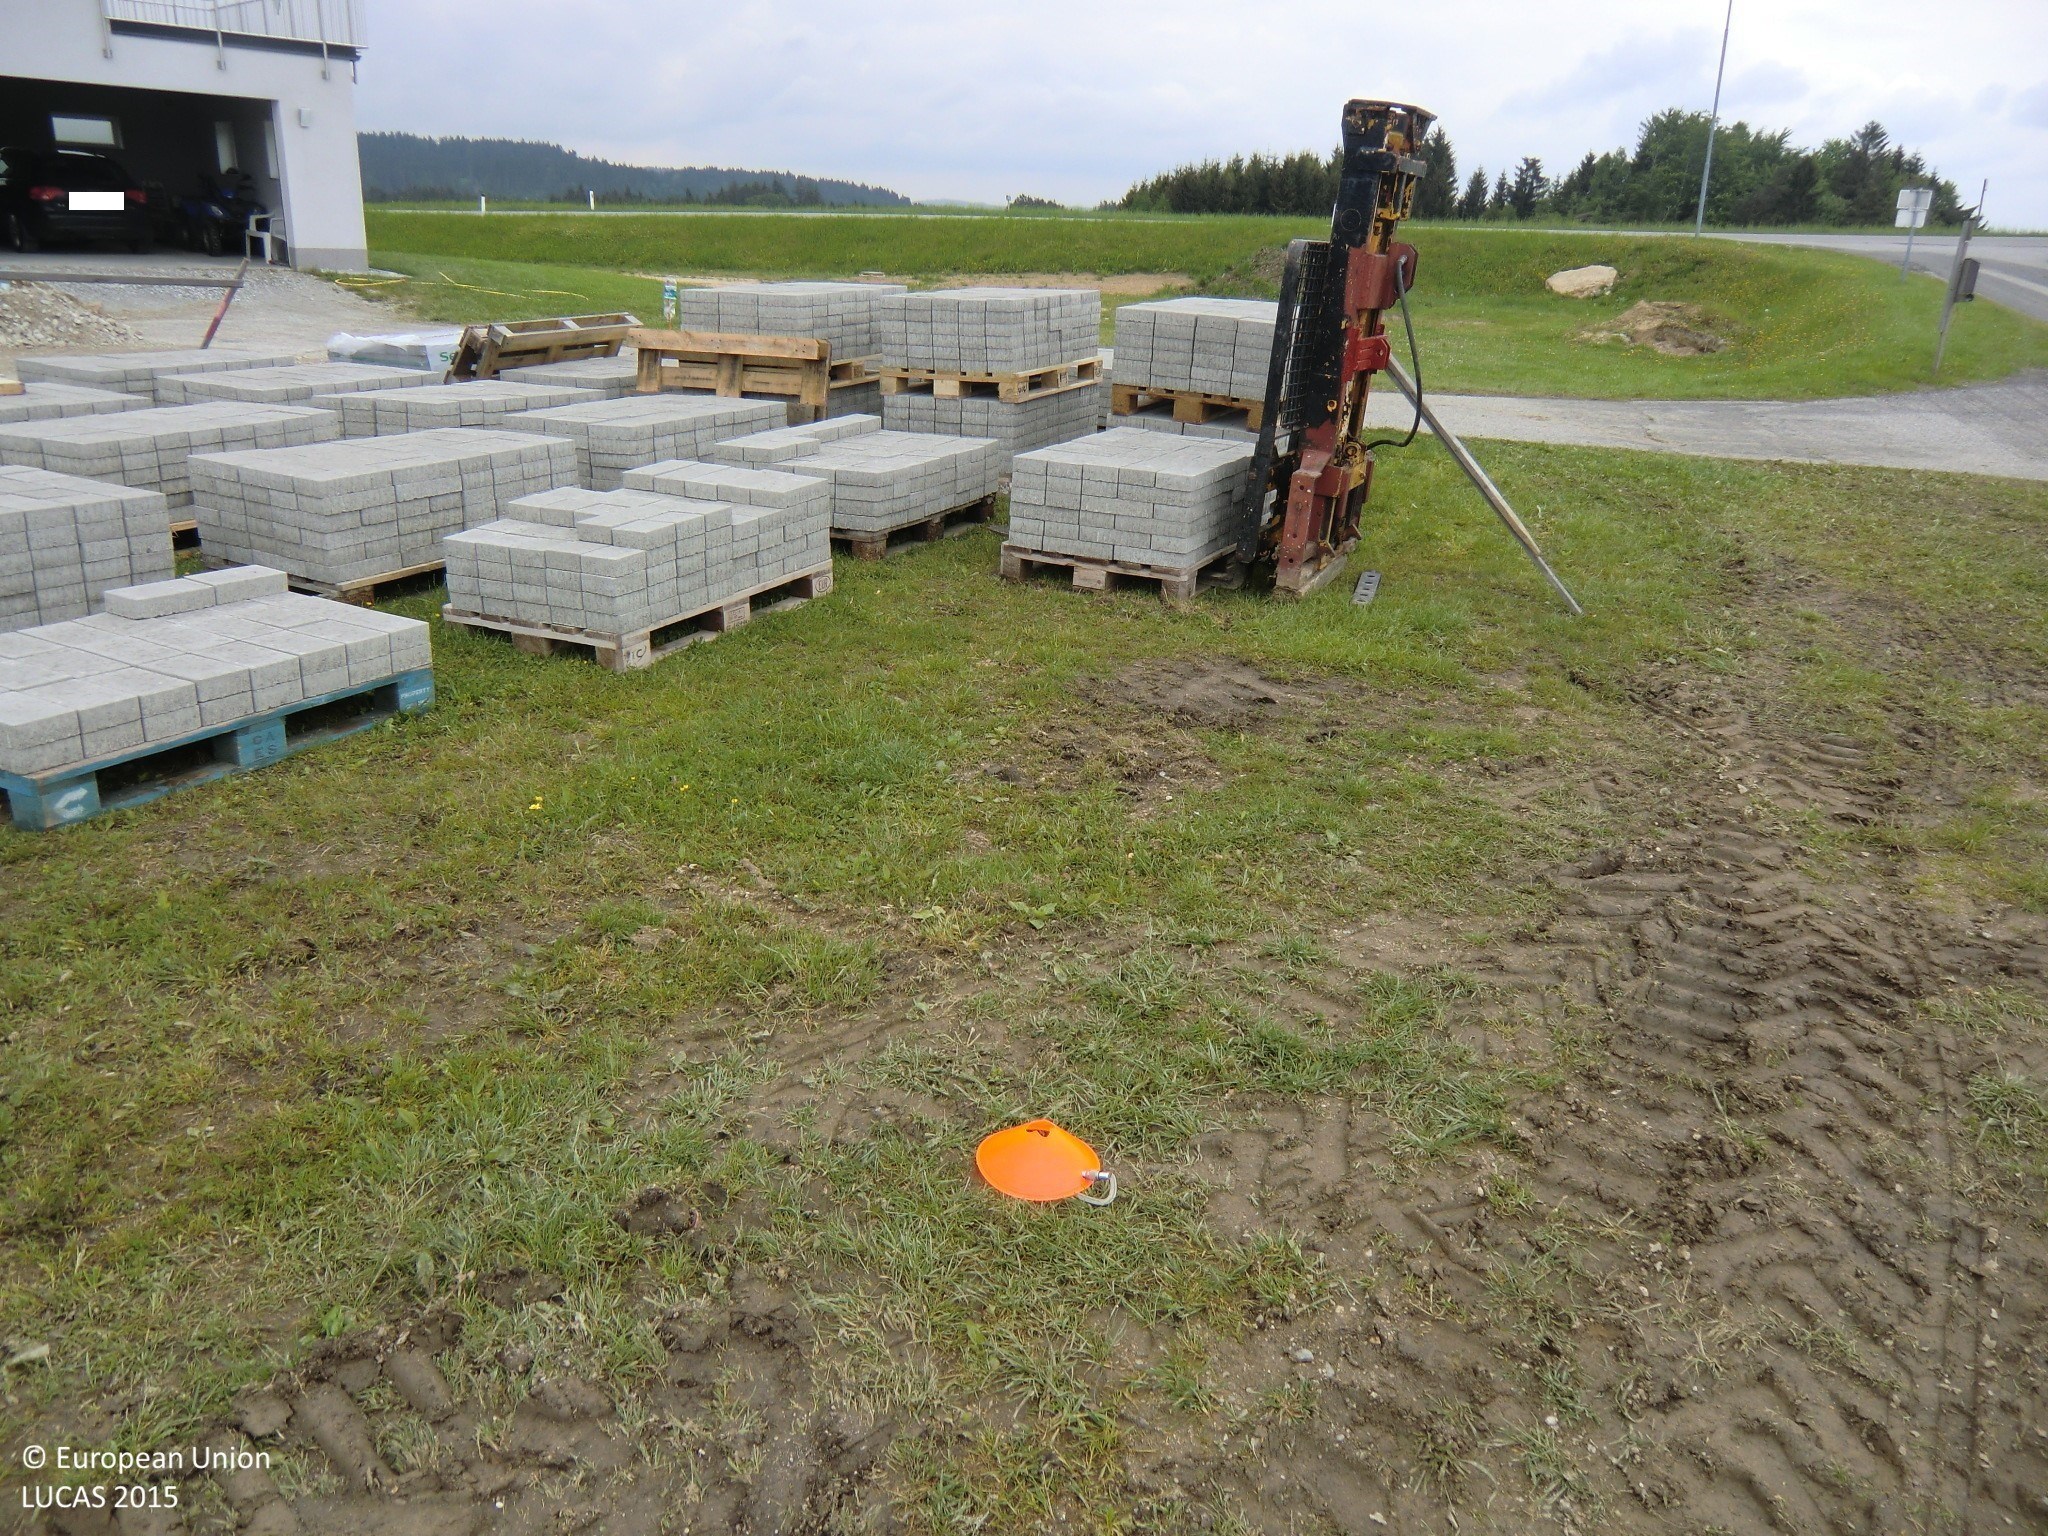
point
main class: Grassland
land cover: Spontaneously vegetated surfaces
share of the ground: 25 - 50 %
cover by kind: herbaceous plants 50 %, unconsolidated bare surface 50 %
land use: Residential
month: May
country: AT
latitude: 48.4363
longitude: 14.9621
